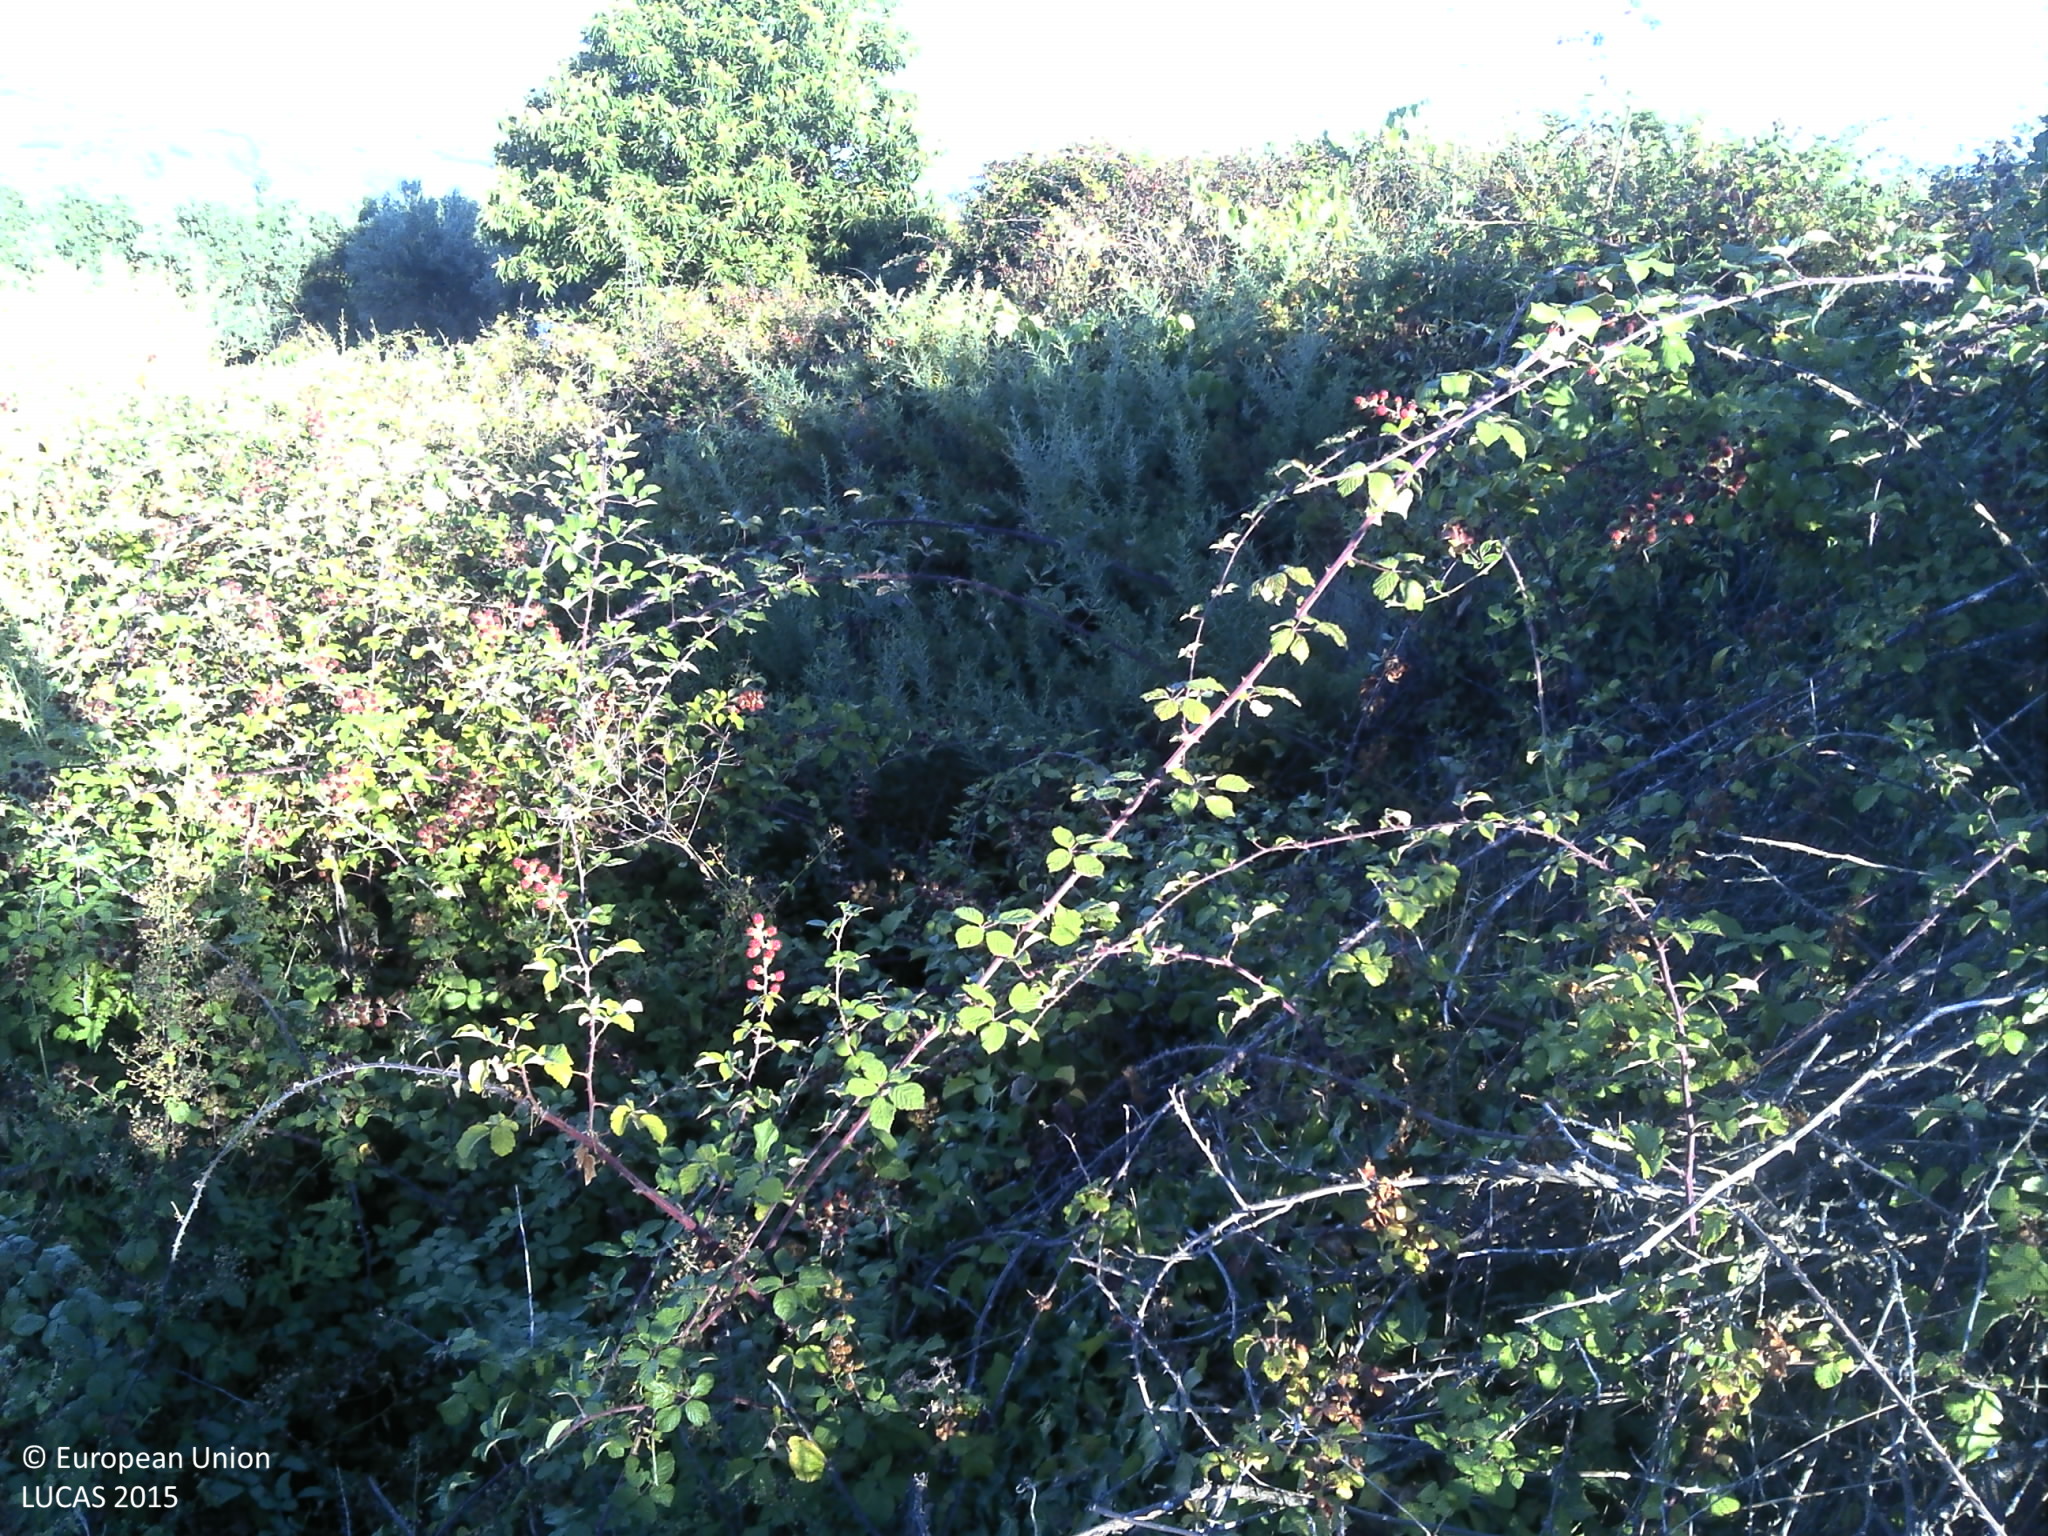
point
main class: Shrubland
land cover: Shrubland without tree cover
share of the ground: > 75 %
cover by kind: shrubs 100 %
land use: Abandoned areas
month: July
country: PT
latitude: 41.2965
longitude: -7.5244
